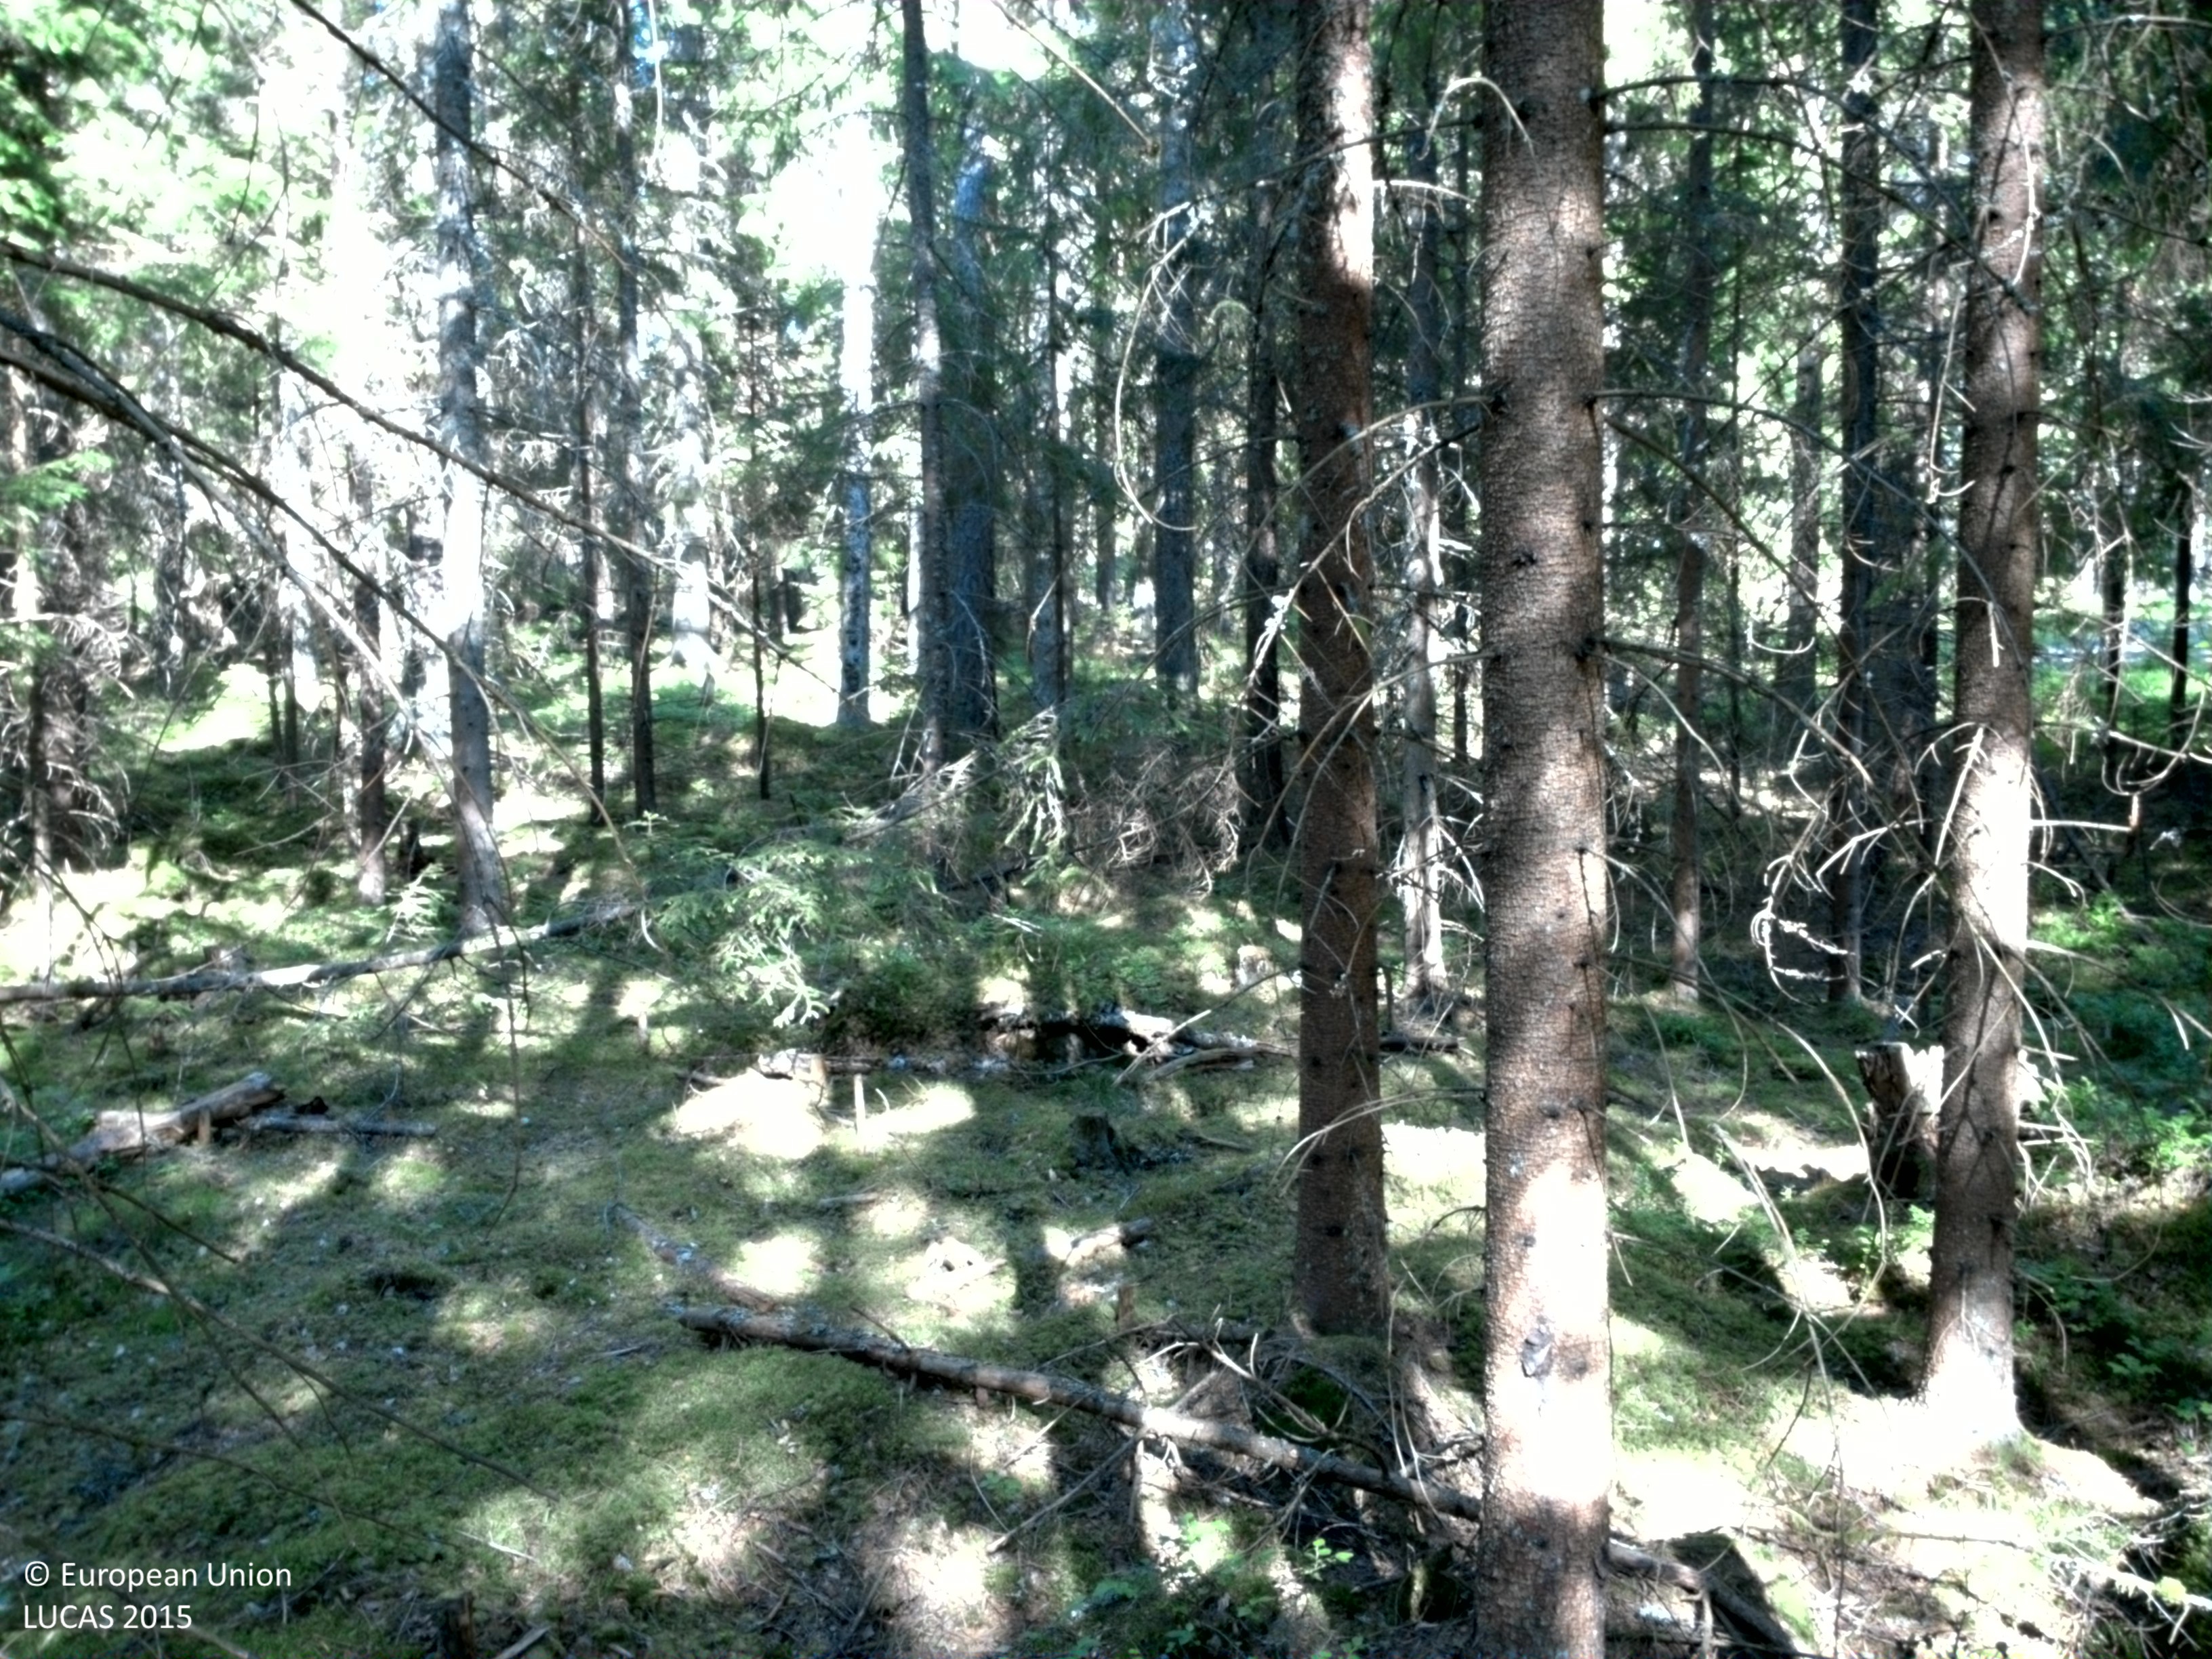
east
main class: Woodland
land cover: Spruce dominated coniferous woodland
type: boreal forest
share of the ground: > 75 %
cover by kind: coniferous forest trees 90 %, broadleaved forest trees 5 %, lichens and mosses 5 %
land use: Forestry
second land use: Community services
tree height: > 5 m
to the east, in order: Spruce dominated coniferous woodland; Spruce dominated mixed woodland; Lichens and moss; Shrubland with sparse tree cover; Spruce dominated mixed woodland; Grass margins; Paved roads, cycling and walking lanes; Grass margins; Spruce dominated mixed woodland; Spruce dominated coniferous woodland
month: June
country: SE
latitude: 58.5941
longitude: 14.5183
